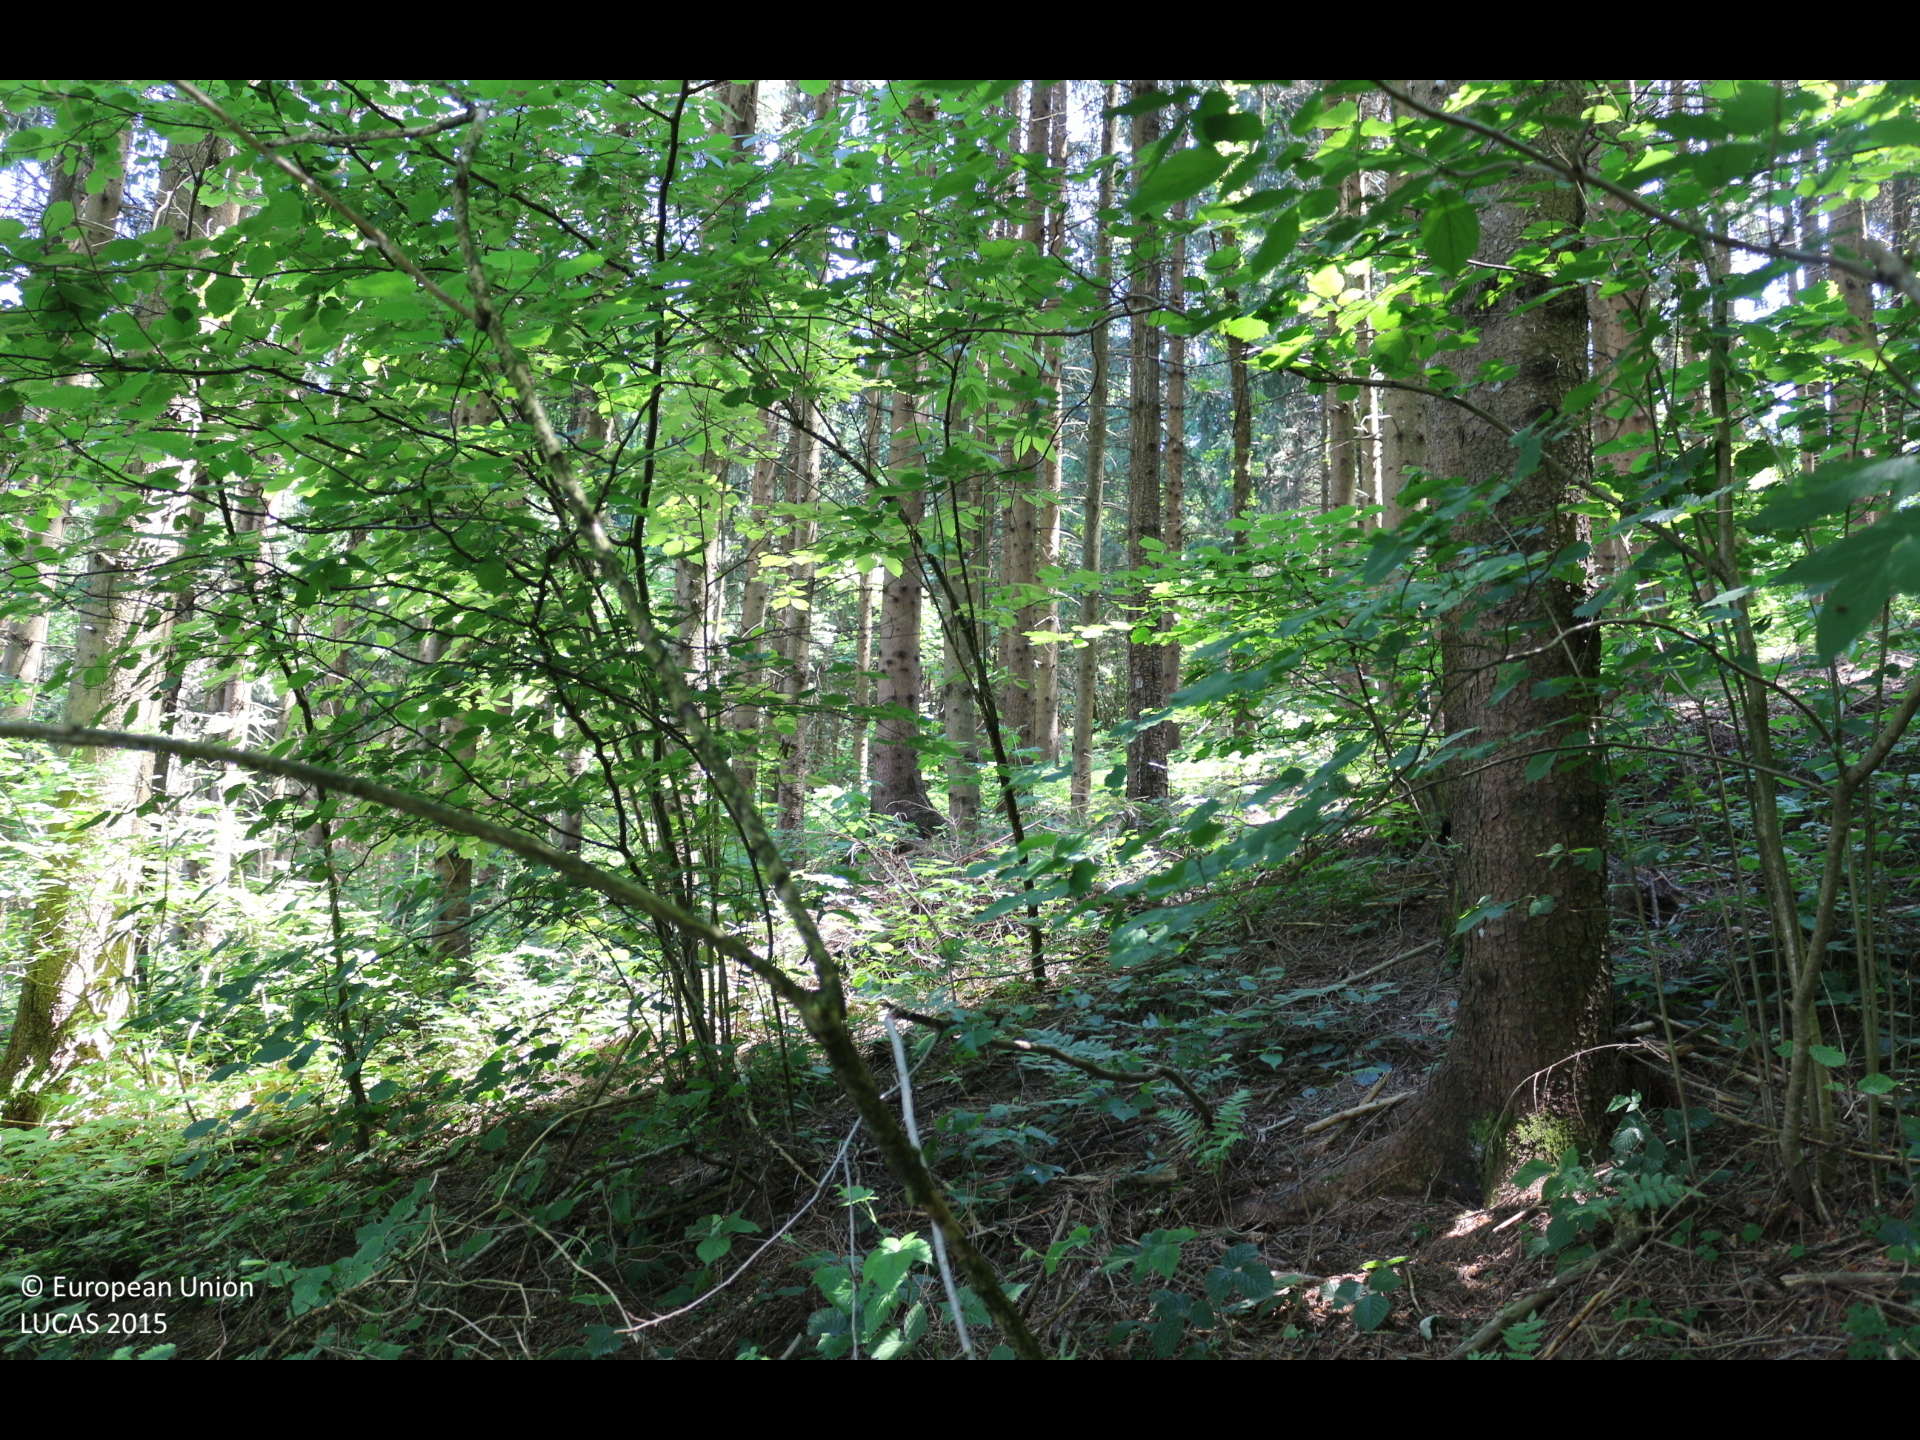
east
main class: Woodland
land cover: Spruce dominated coniferous woodland
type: alpine coniferous forest
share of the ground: > 75 %
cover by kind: coniferous forest trees 80 %, broadleaved forest trees 10 %, shrubs 10 %
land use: Forestry
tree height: > 5 m
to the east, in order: Spruce dominated coniferous woodland; Spruce dominated mixed woodland; Tracks; Spruce dominated mixed woodland; Pine dominated mixed woodland; Temporary grasslands; Electric lines; Temporary grasslands
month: June
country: AT
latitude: 46.6878
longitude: 14.0900
